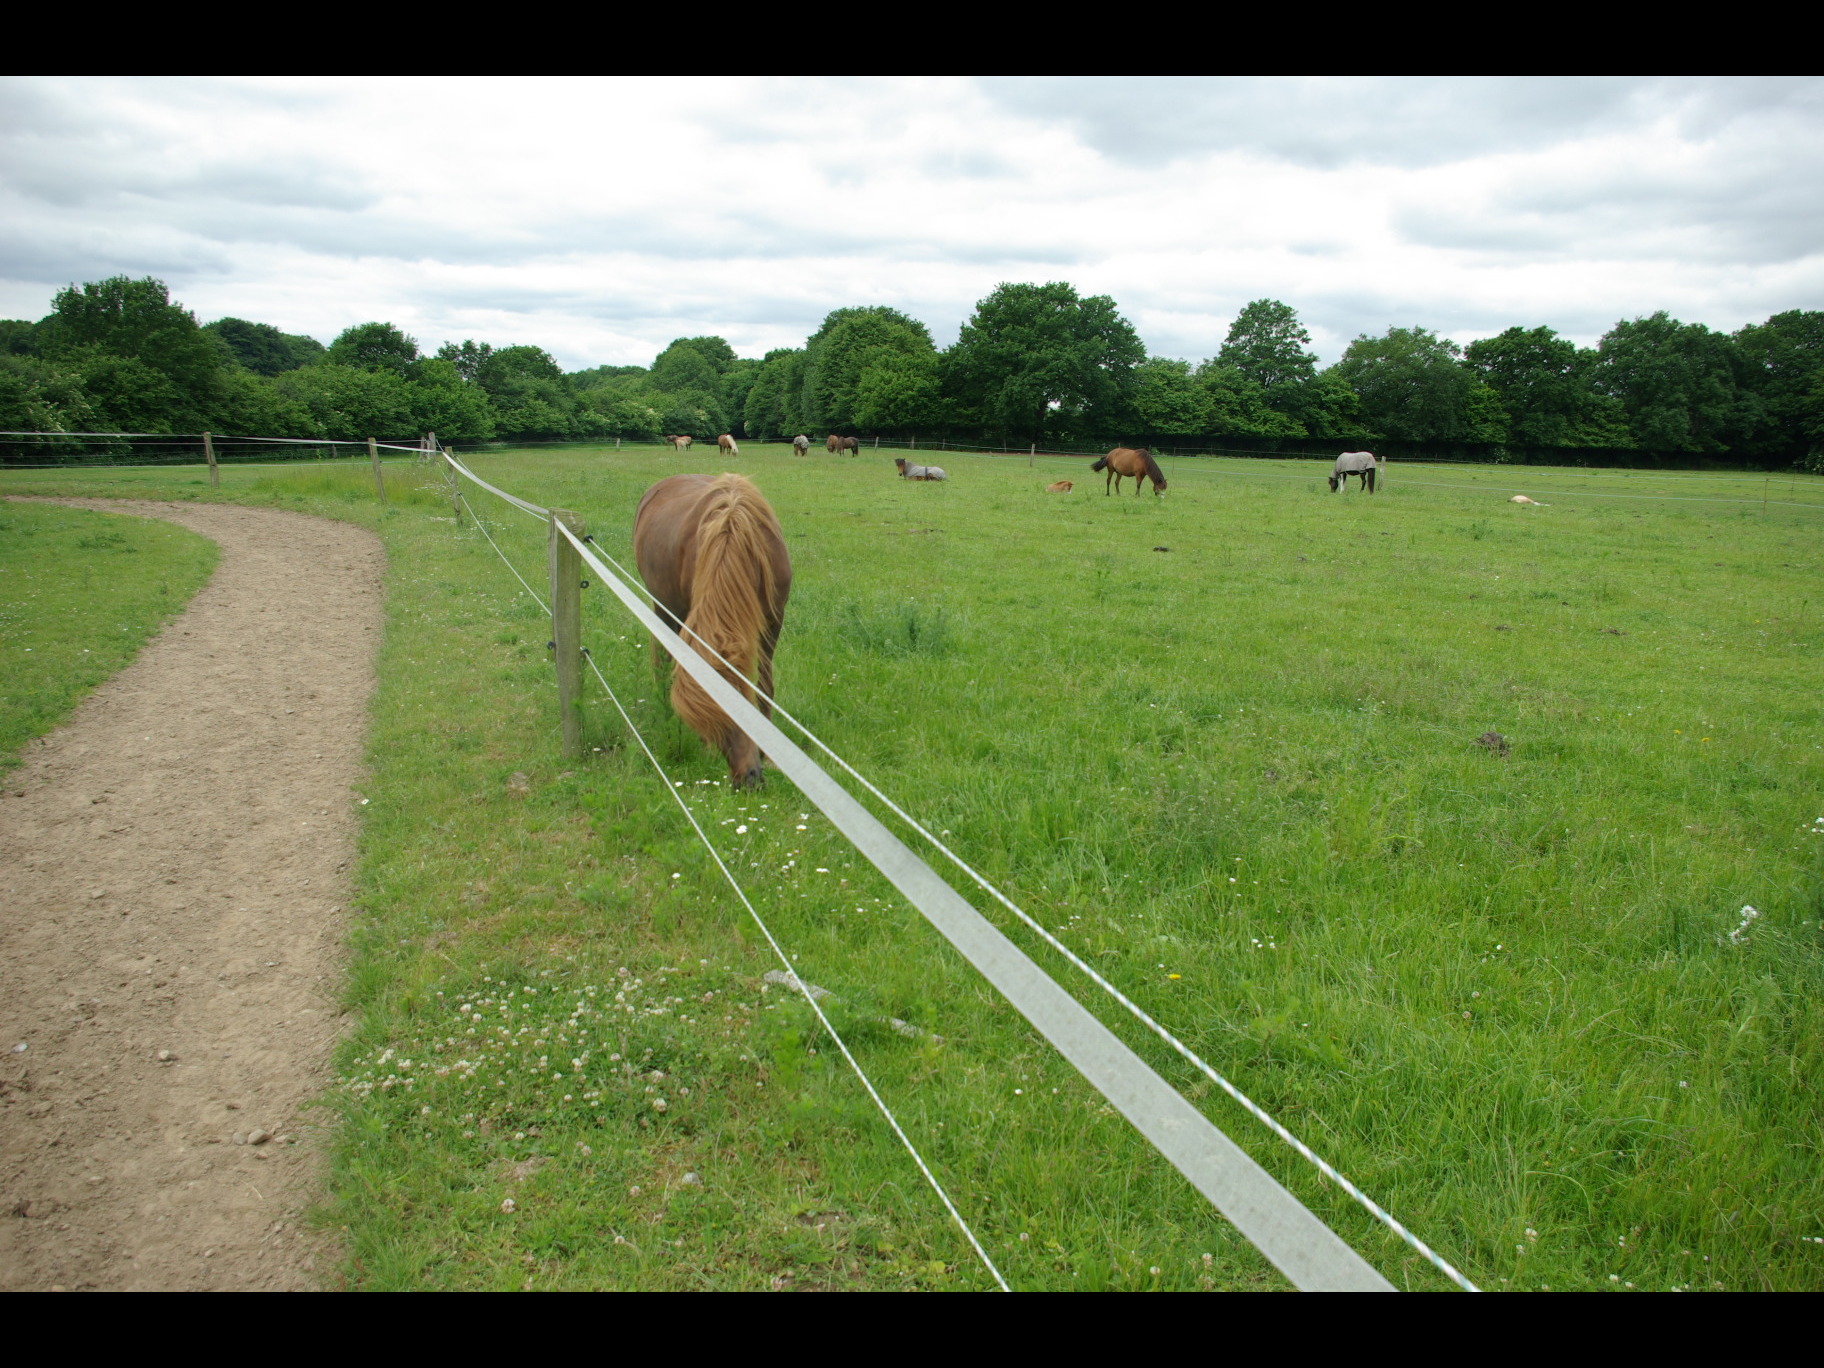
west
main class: Grassland
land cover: Grassland without tree/shrub cover
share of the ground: > 75 %
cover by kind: herbaceous plants 100 %
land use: Agriculture (excluding fallow land and kitchen gardens)
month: June
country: DE
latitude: 54.0489
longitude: 9.8931
